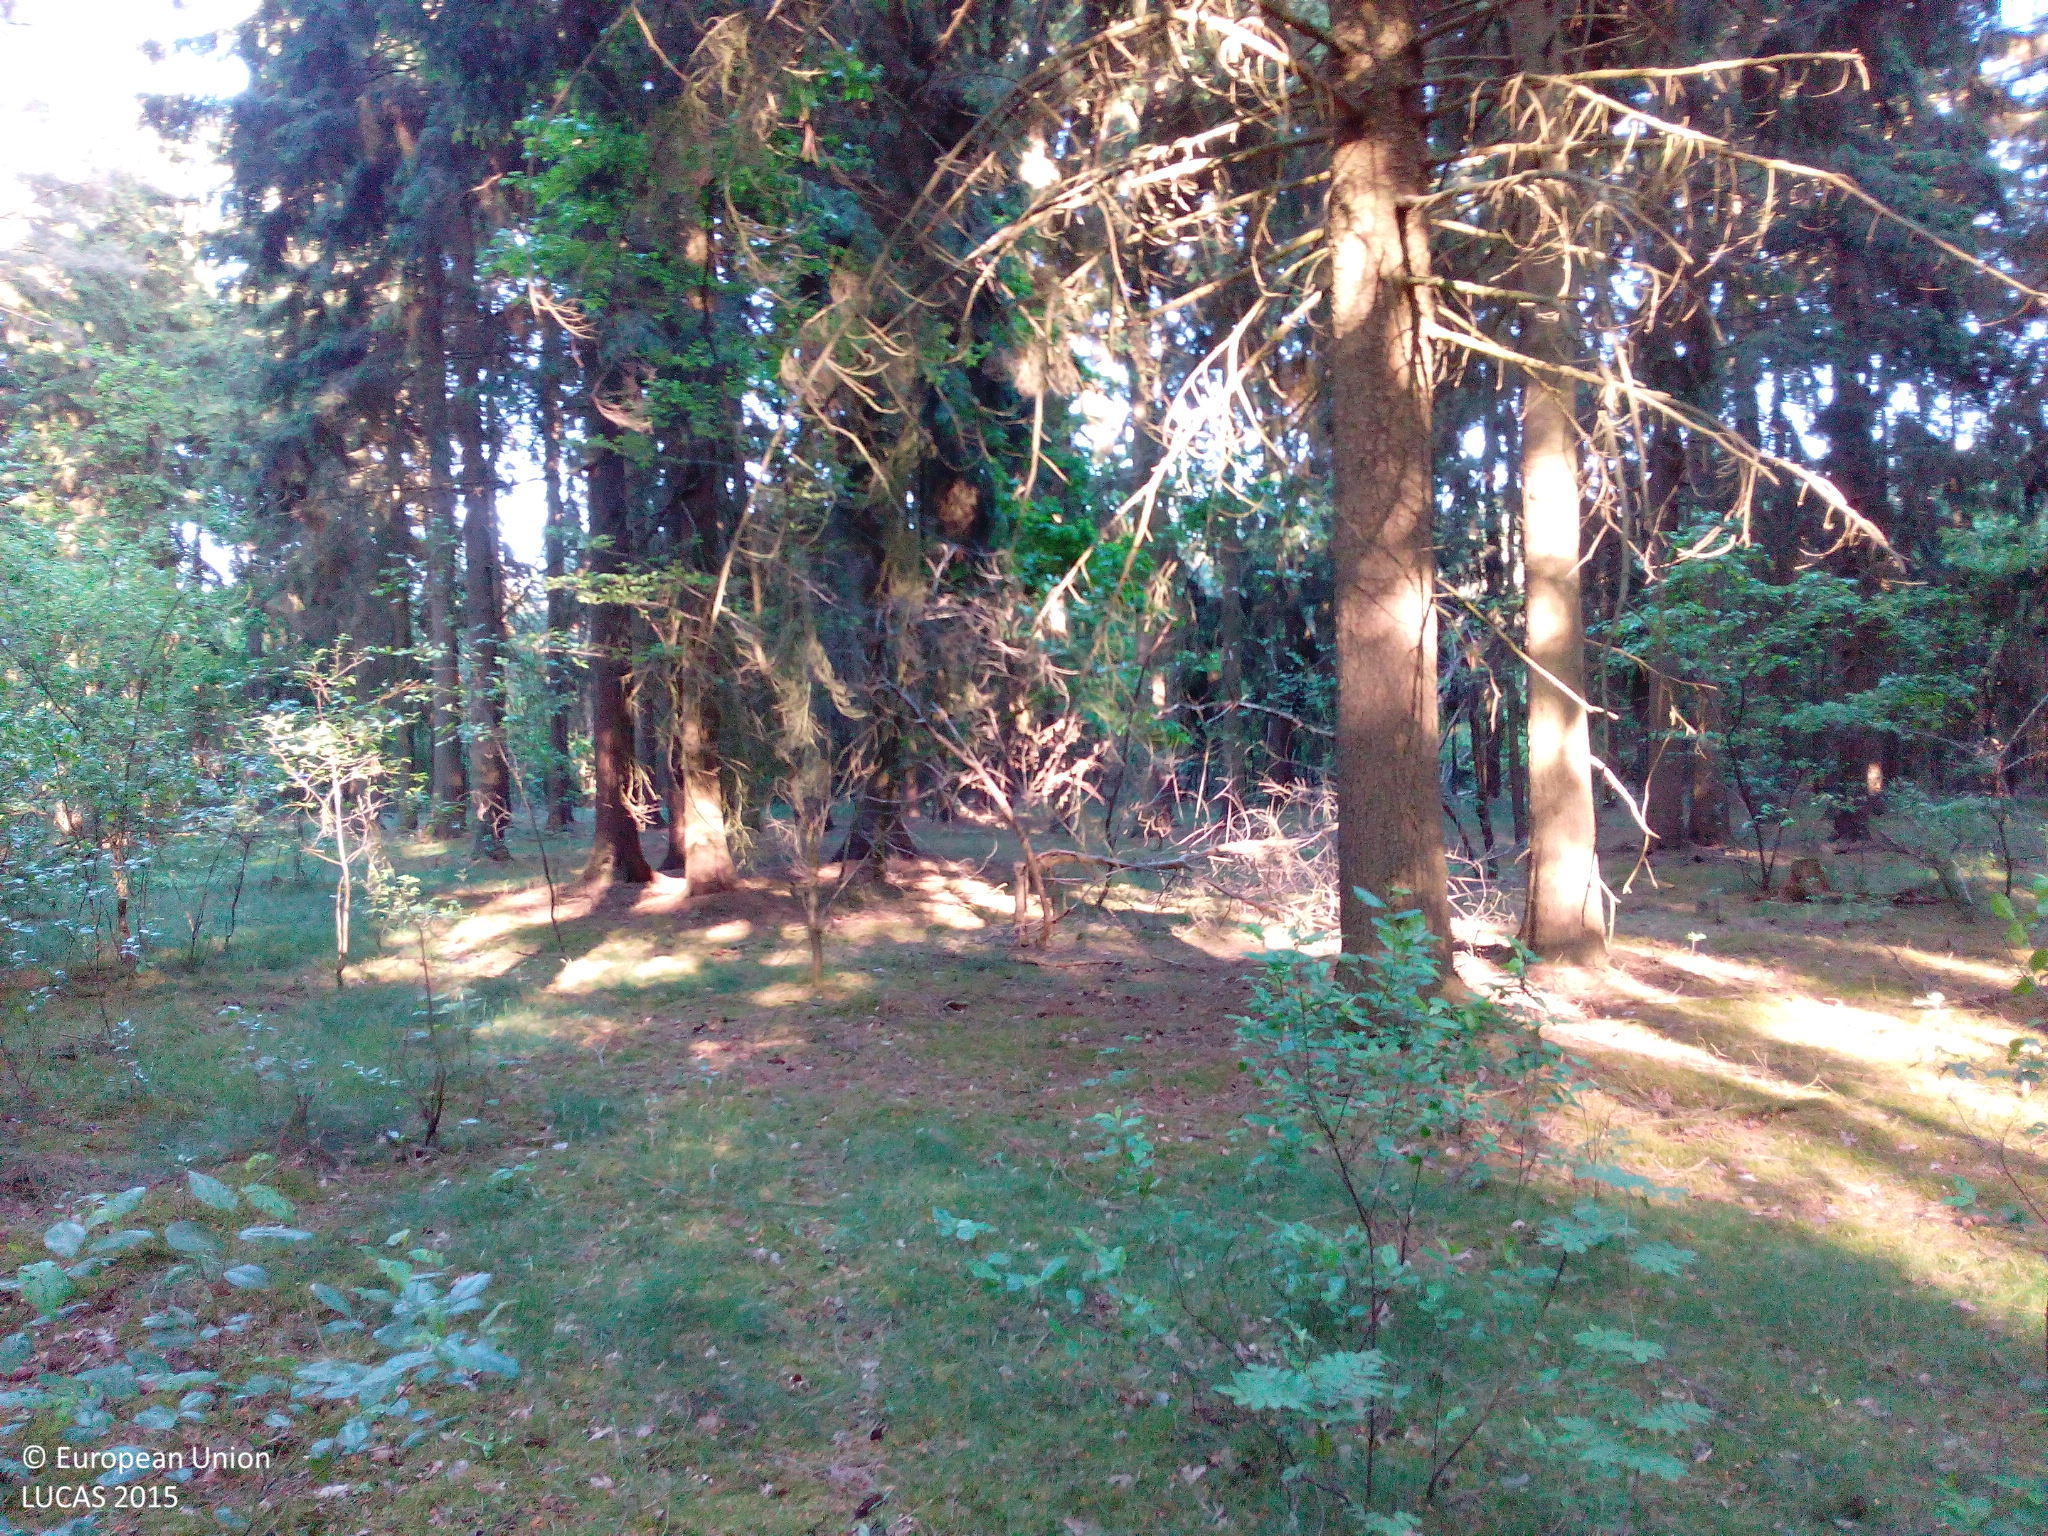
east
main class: Woodland
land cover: Pine dominated coniferous woodland
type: hemiboreal forest and nemoral coniferous forest and mixed broadleaved-coniferous forest
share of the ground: 50 - 75 %
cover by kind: coniferous forest trees 50 %, broadleaved forest trees 15 %, herbaceous plants 15 %, lichens and mosses 10 %, shrubs 5 %, unconsolidated bare surface 5 %
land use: Forestry
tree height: > 5 m
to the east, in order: Pine dominated coniferous woodland; Tracks; Pine dominated coniferous woodland
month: June
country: DE
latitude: 53.2353
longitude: 12.3516
